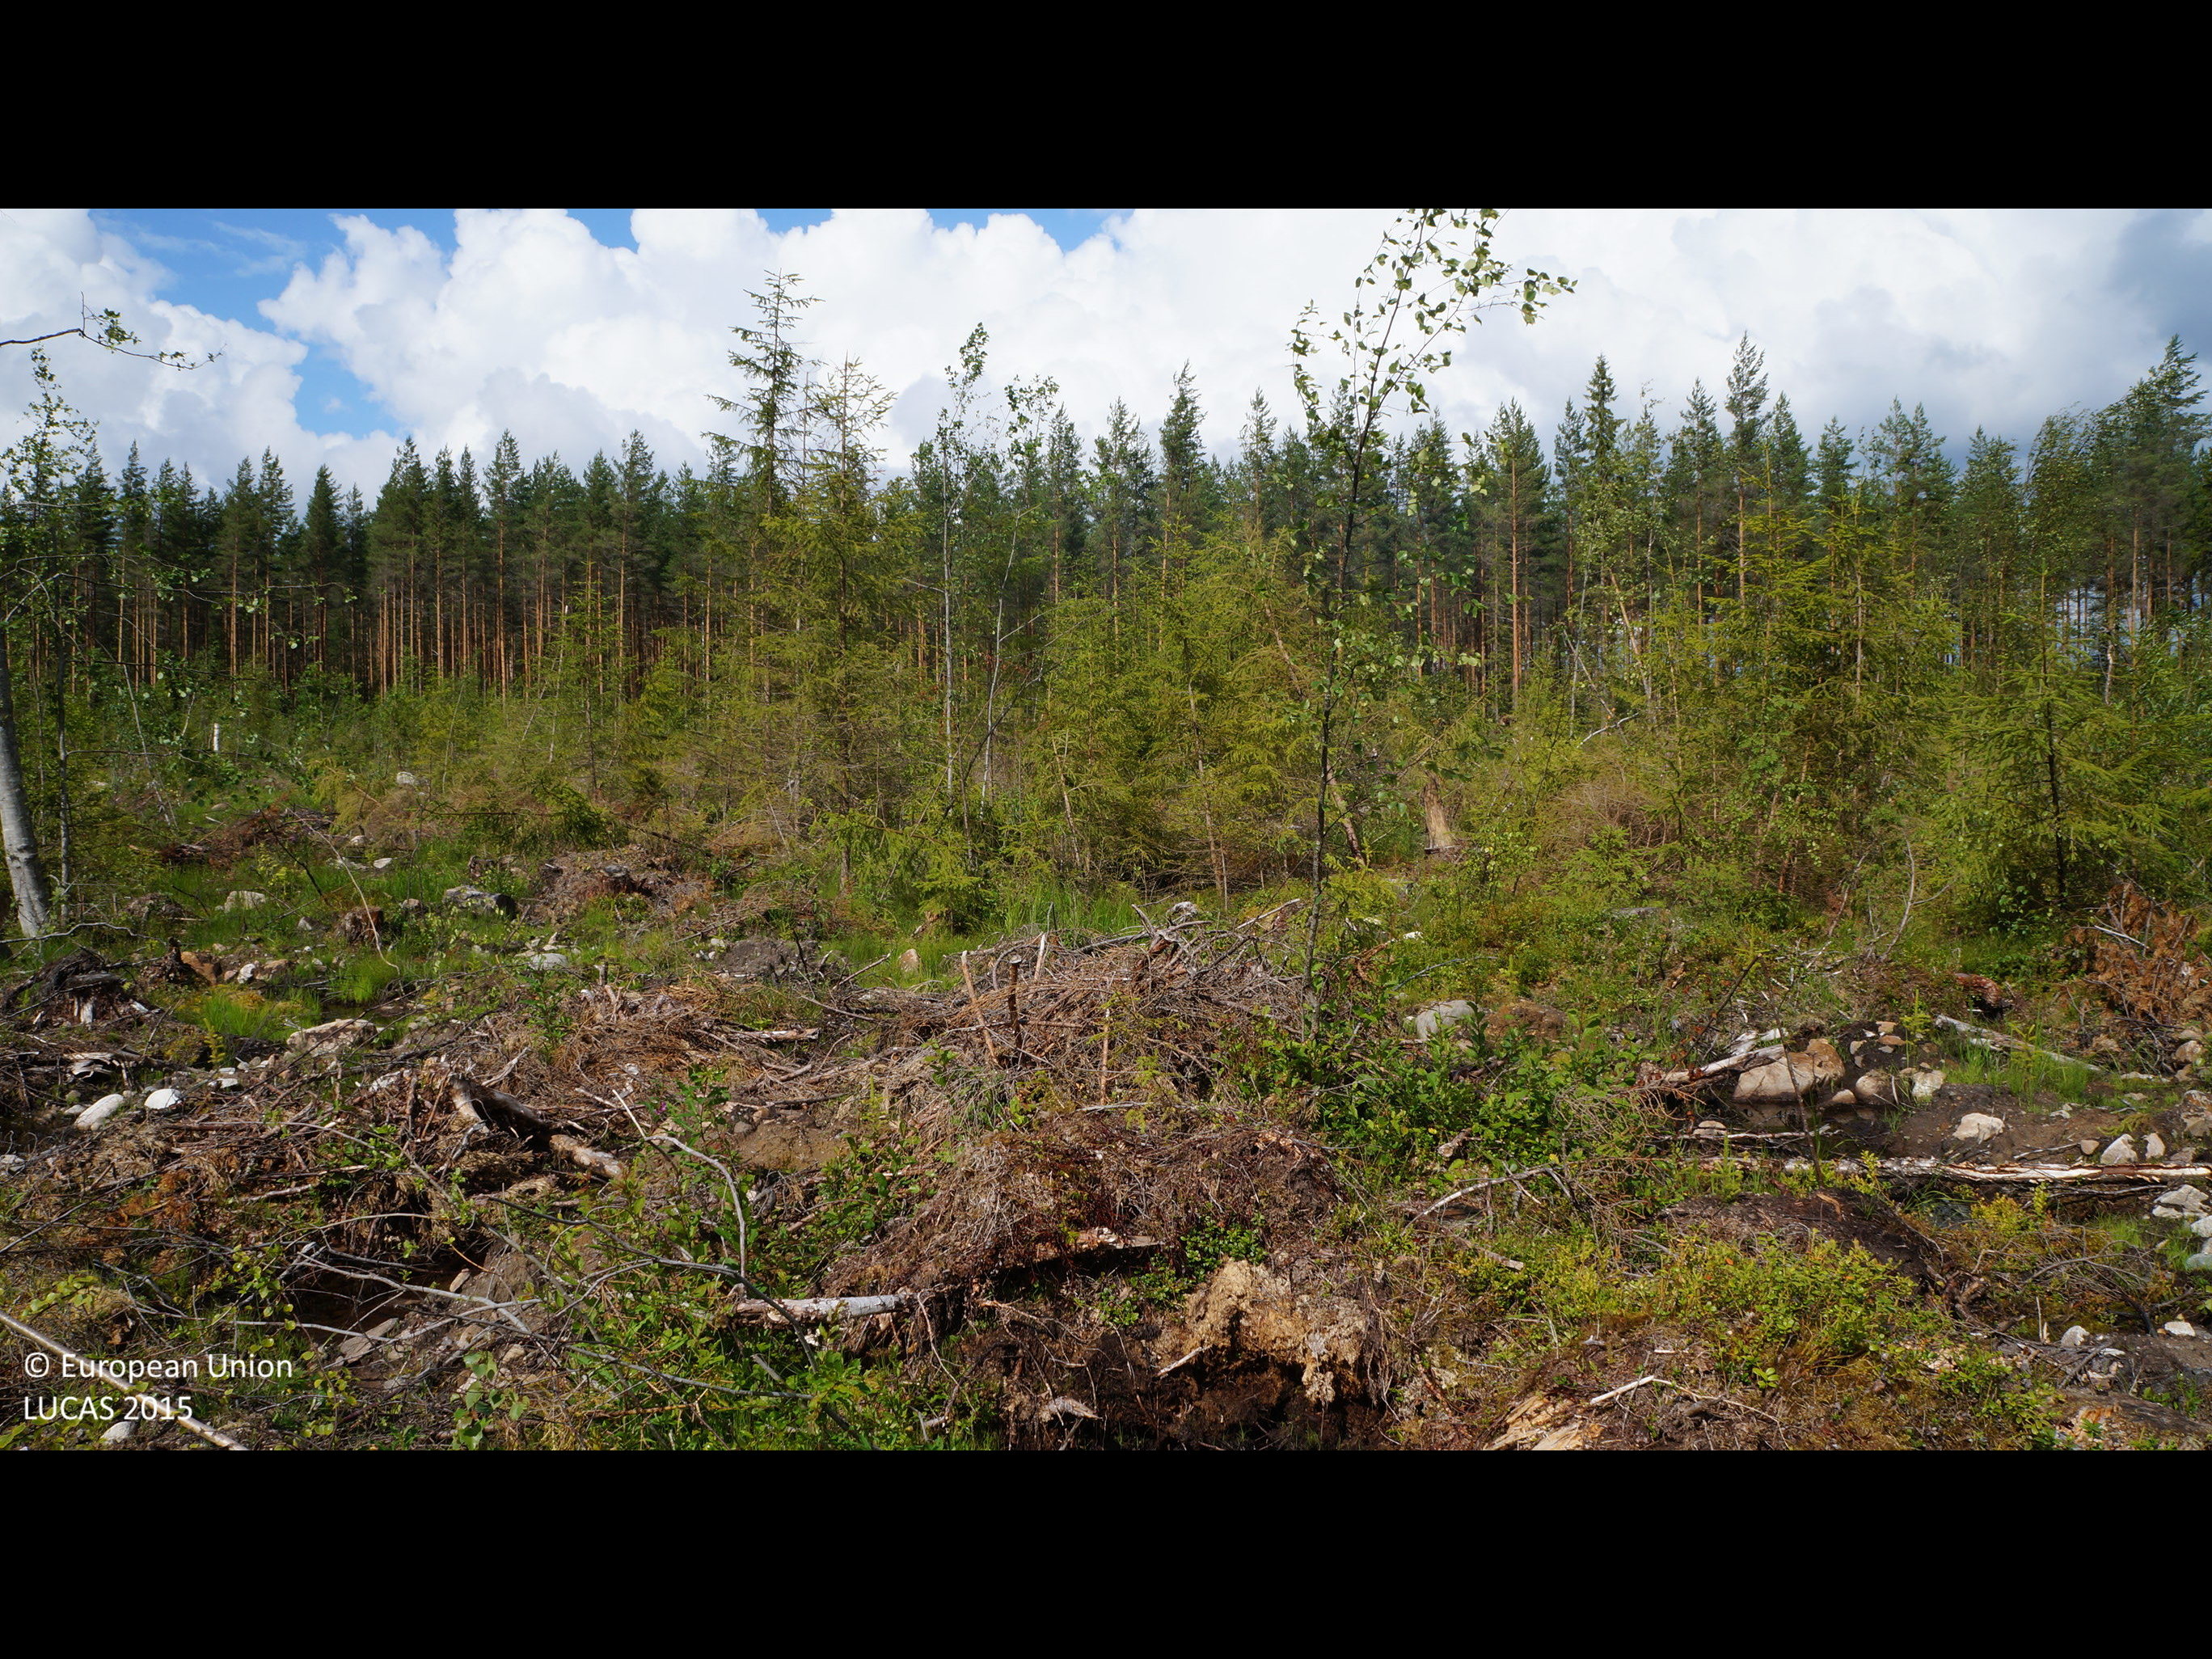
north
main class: Shrubland
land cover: Shrubland with sparse tree cover
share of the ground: 50 - 75 %
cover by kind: shrubs 65 %, unconsolidated bare surface 20 %, consolidated bare surface 10 %, coniferous forest trees 5 %
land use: Forestry
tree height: > 5 m
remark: Clear cut
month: July
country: FI
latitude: 63.8502
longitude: 24.9518
